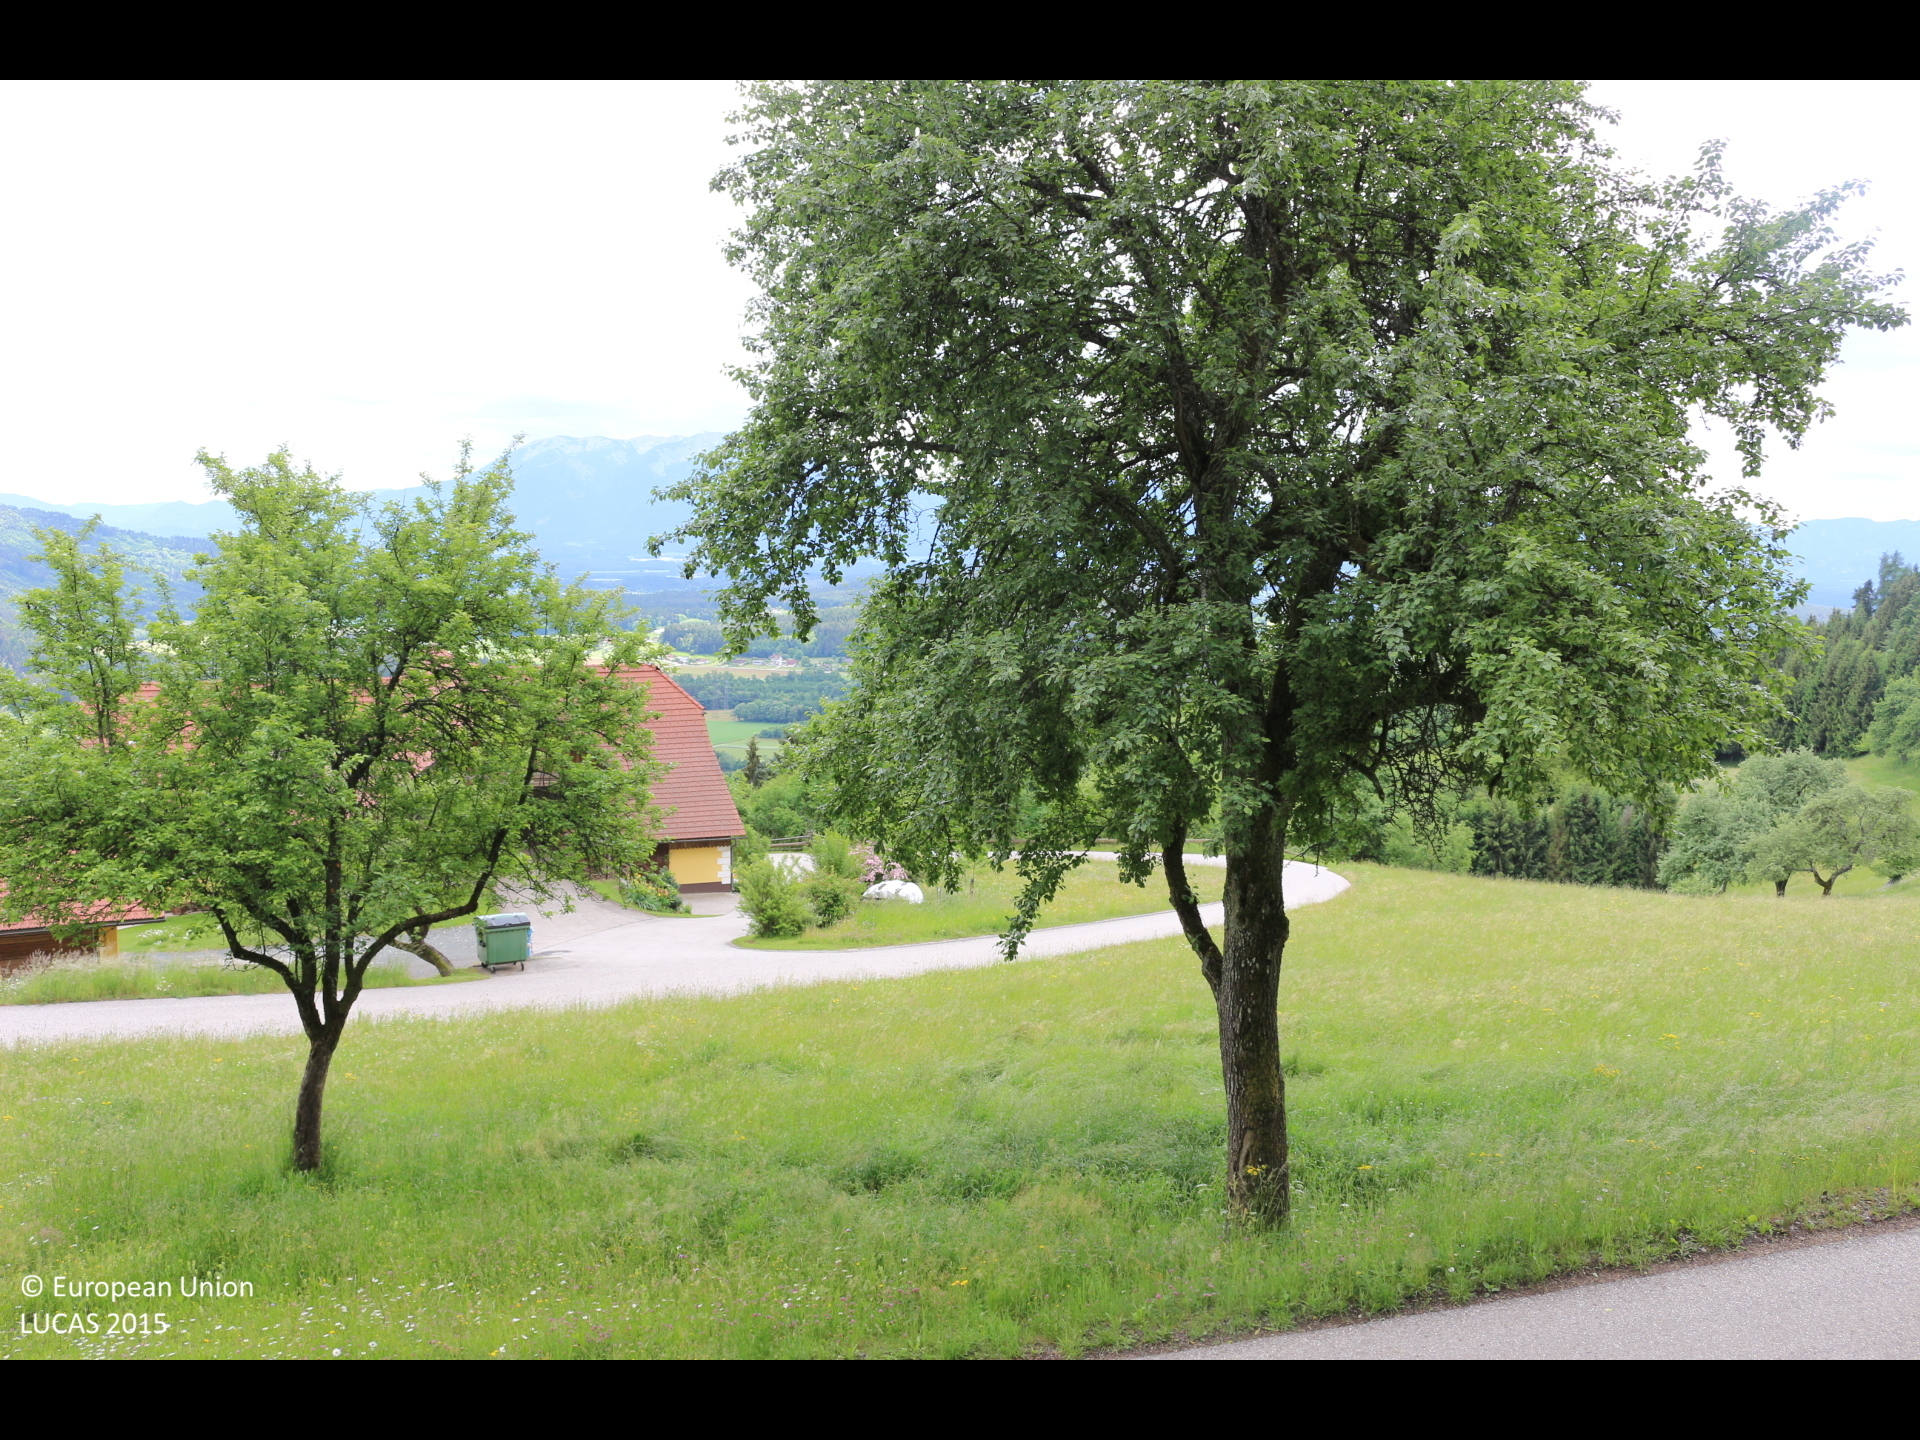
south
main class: Grassland
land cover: Grassland with sparse tree/shrub cover
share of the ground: > 75 %
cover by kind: herbaceous plants 90 %, broadleaved forest trees 5 %, shrubs 5 %
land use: Agriculture (excluding fallow land and kitchen gardens)
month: May
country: AT
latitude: 46.6992
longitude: 14.6930
